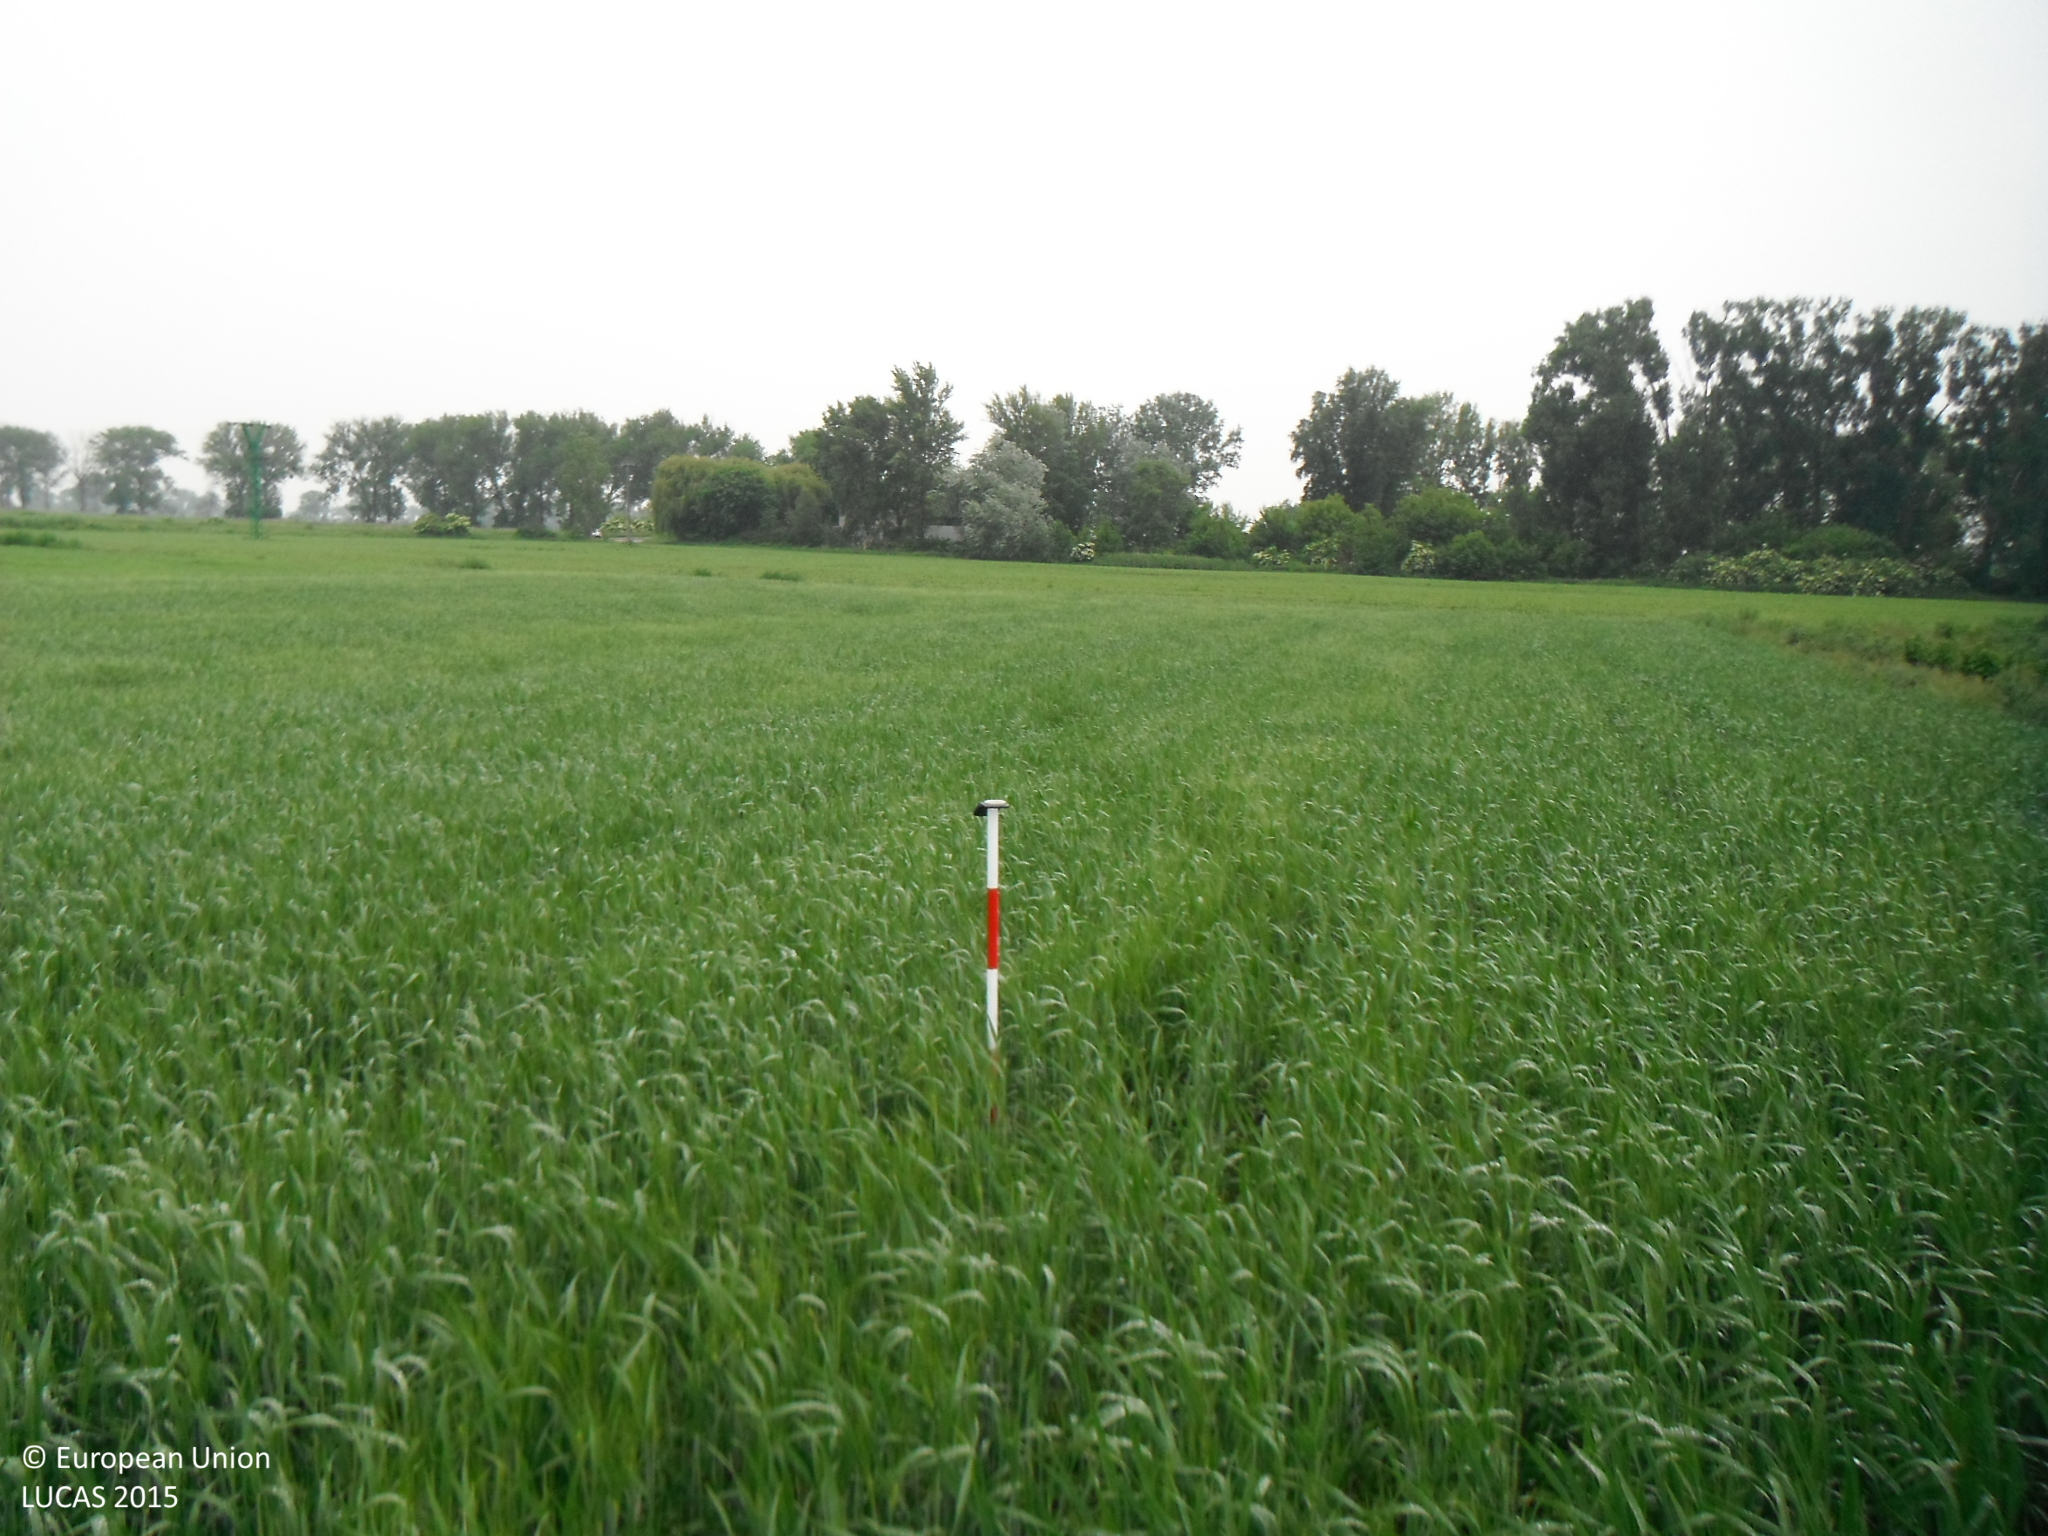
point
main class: Cropland
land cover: Barley
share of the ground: > 75 %
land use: Agriculture (excluding fallow land and kitchen gardens)
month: May
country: SK
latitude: 47.9081
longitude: 17.8377
